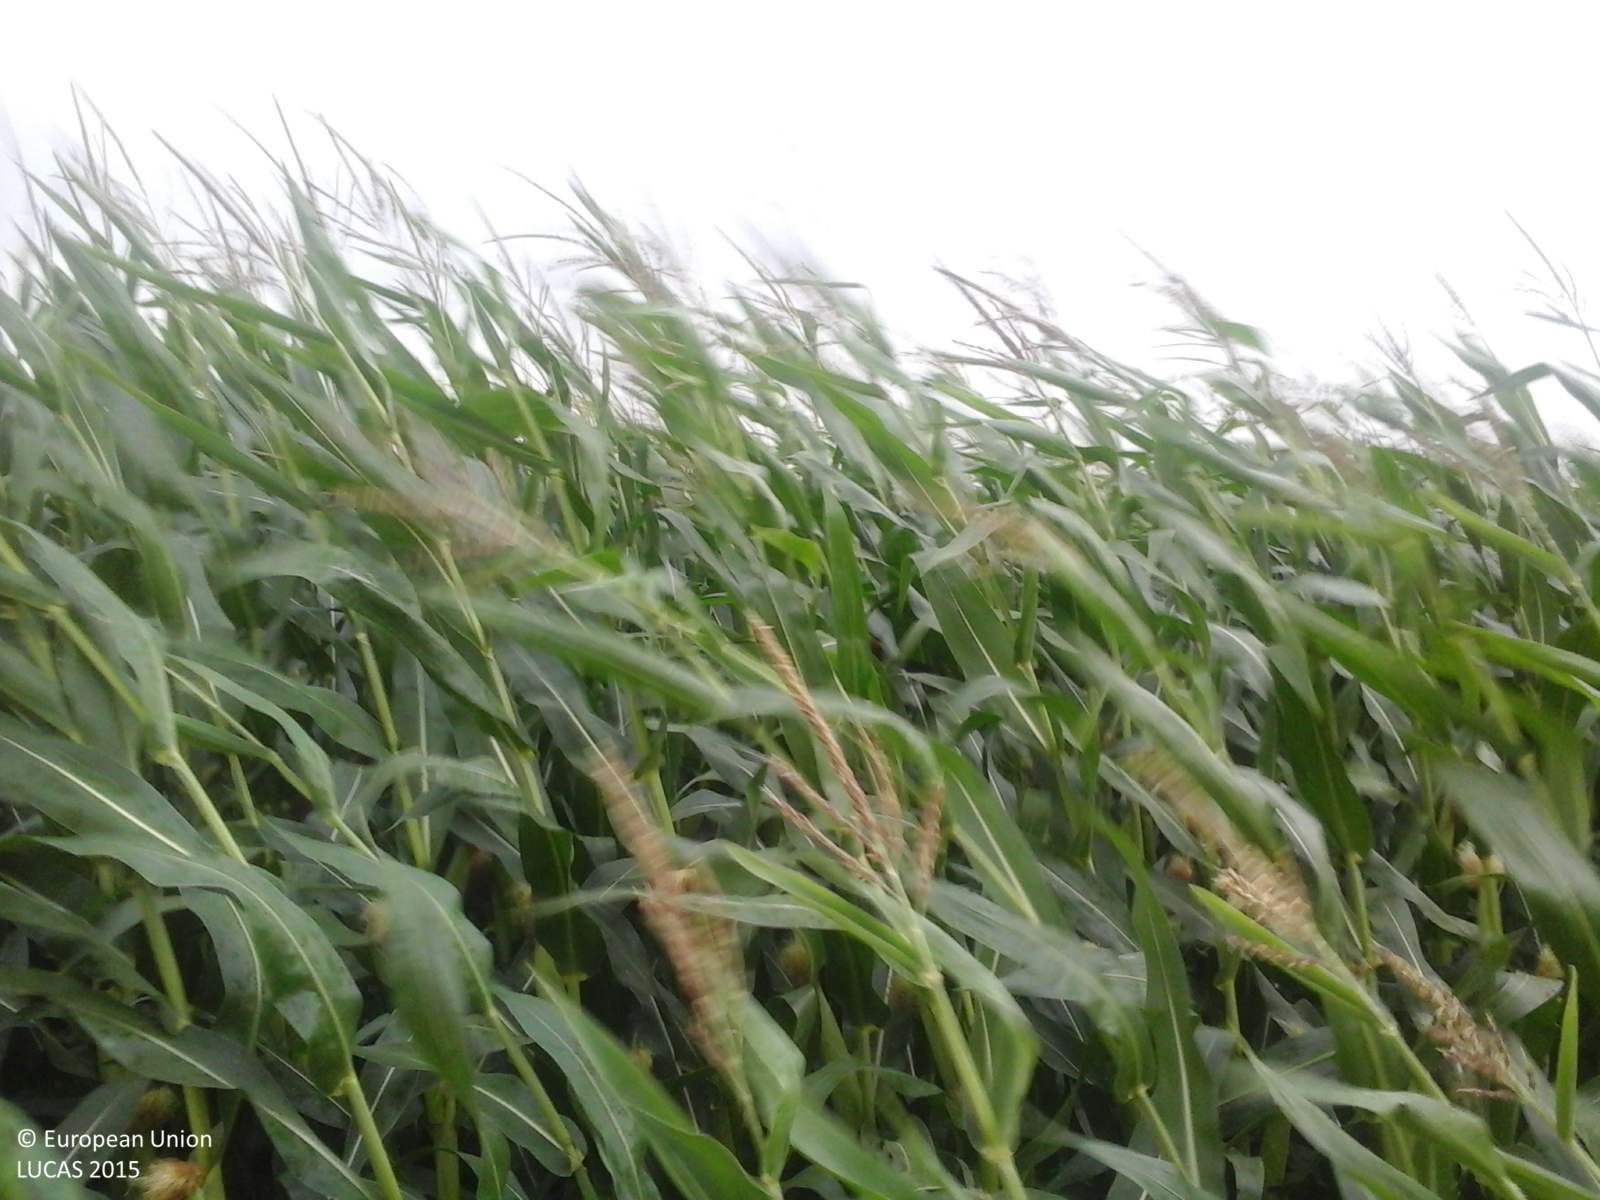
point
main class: Cropland
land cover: Maize
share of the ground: > 75 %
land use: Agriculture (excluding fallow land and kitchen gardens)
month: July
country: RO
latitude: 43.7734
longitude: 25.6802
